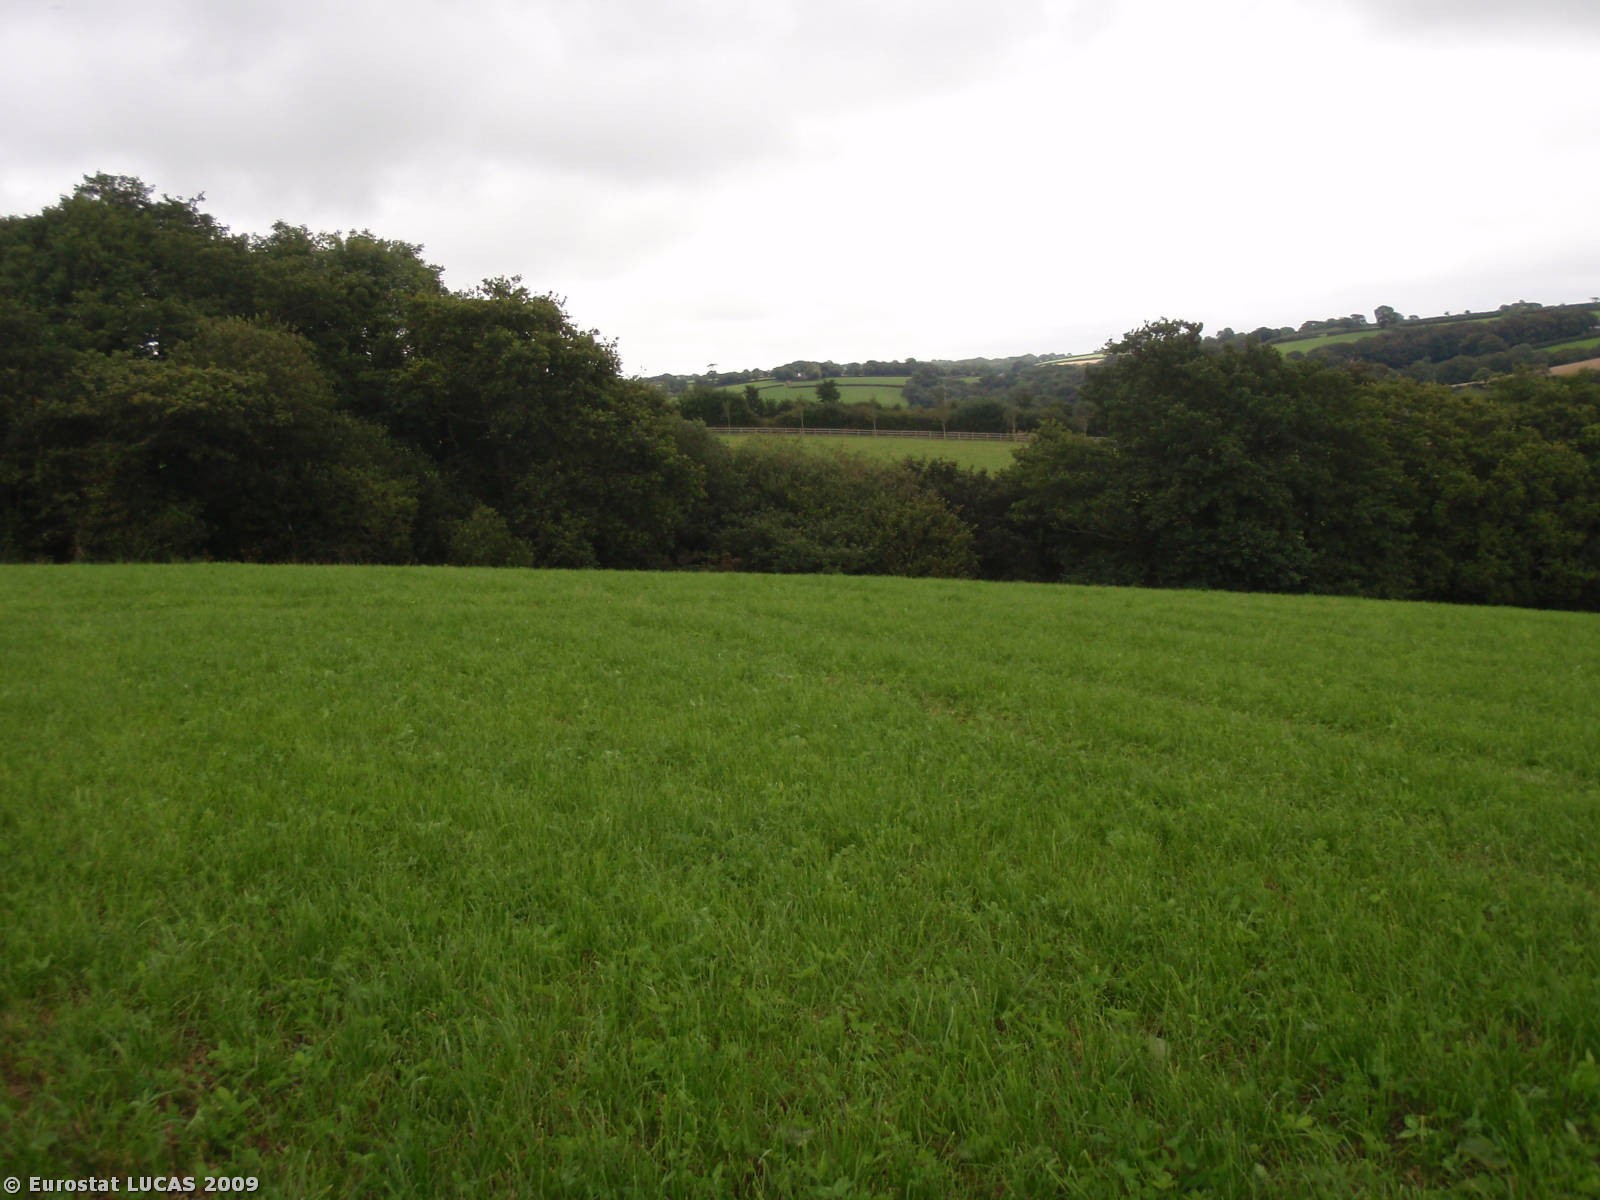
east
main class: Cropland
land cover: Clovers
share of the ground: 50 - 75 %
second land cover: Temporary grasslands
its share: 25 - 50 %
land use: Agriculture (excluding fallow land and kitchen gardens)
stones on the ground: < 10 %
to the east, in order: Clovers; Temporary grasslands; Broadleaved woodland; Rivers and streams; Grassland without tree/shrub cover; Fences; Tracks; Fences; Grassland without tree/shrub cover
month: July
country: GB
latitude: 50.7683
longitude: -4.3514
